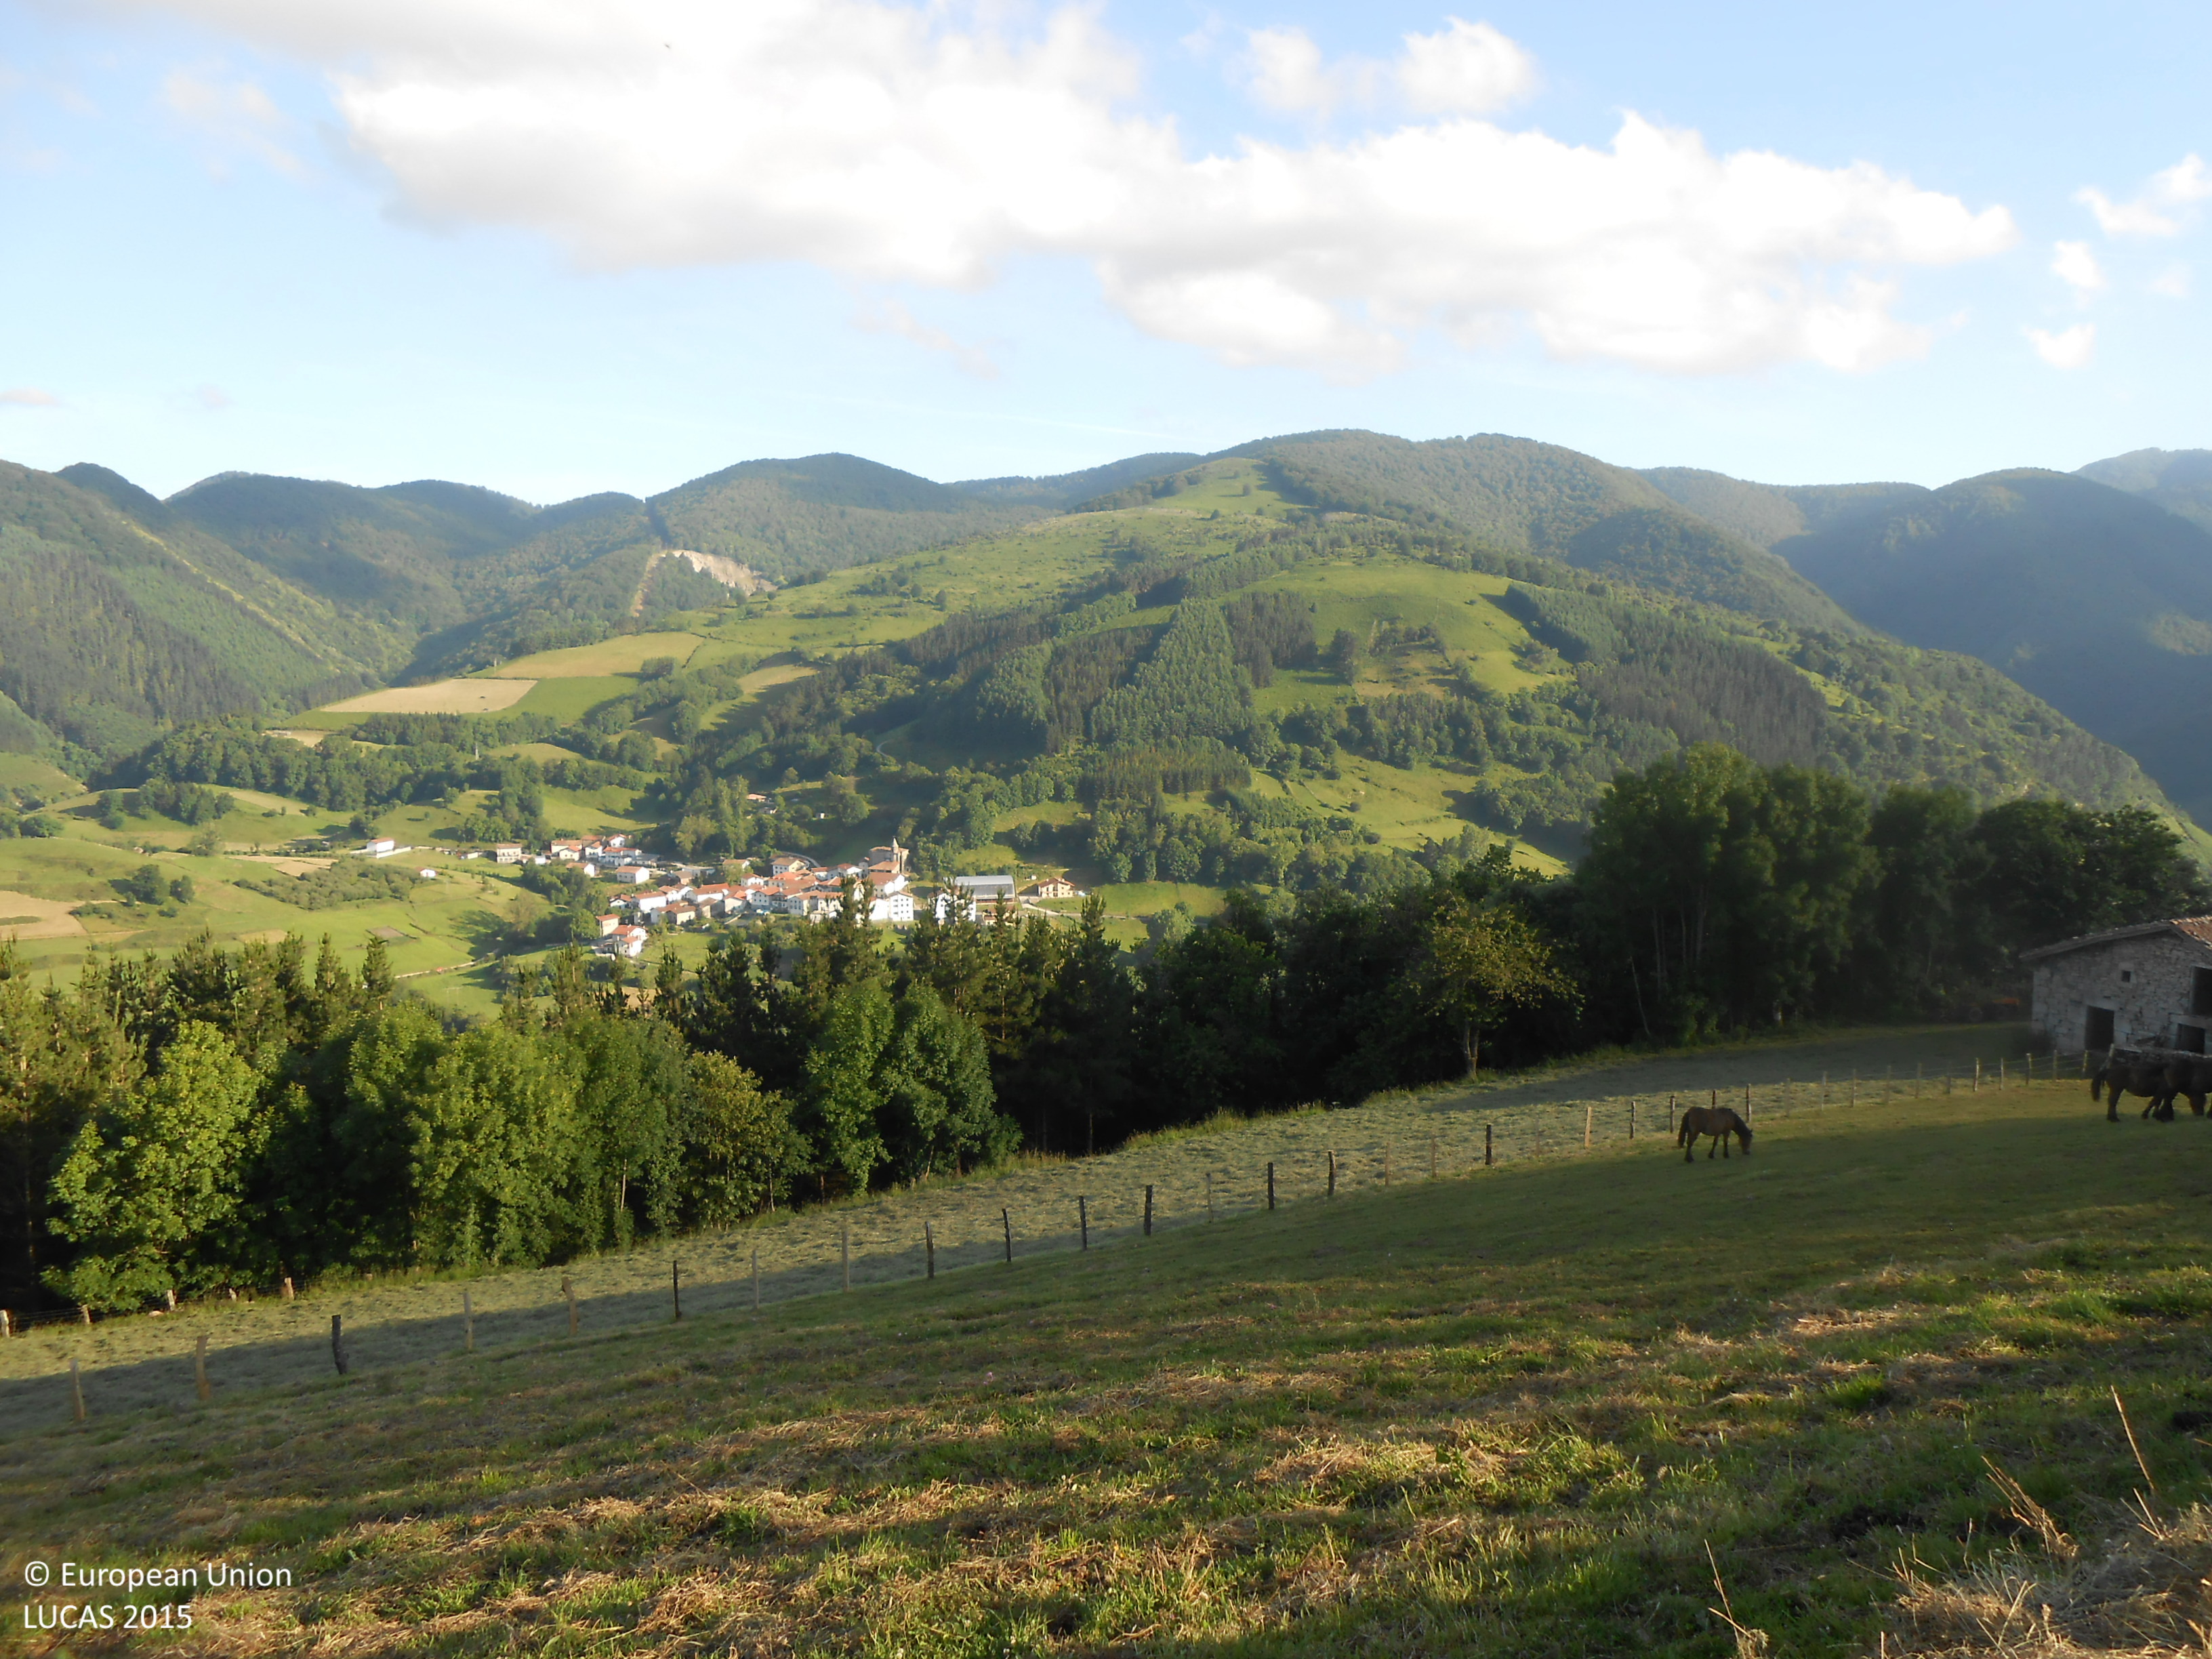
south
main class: Grassland
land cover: Grassland without tree/shrub cover
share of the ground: > 75 %
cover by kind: herbaceous plants 100 %
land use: Agriculture (excluding fallow land and kitchen gardens)
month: June
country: ES
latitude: 43.0918
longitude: -1.7999
